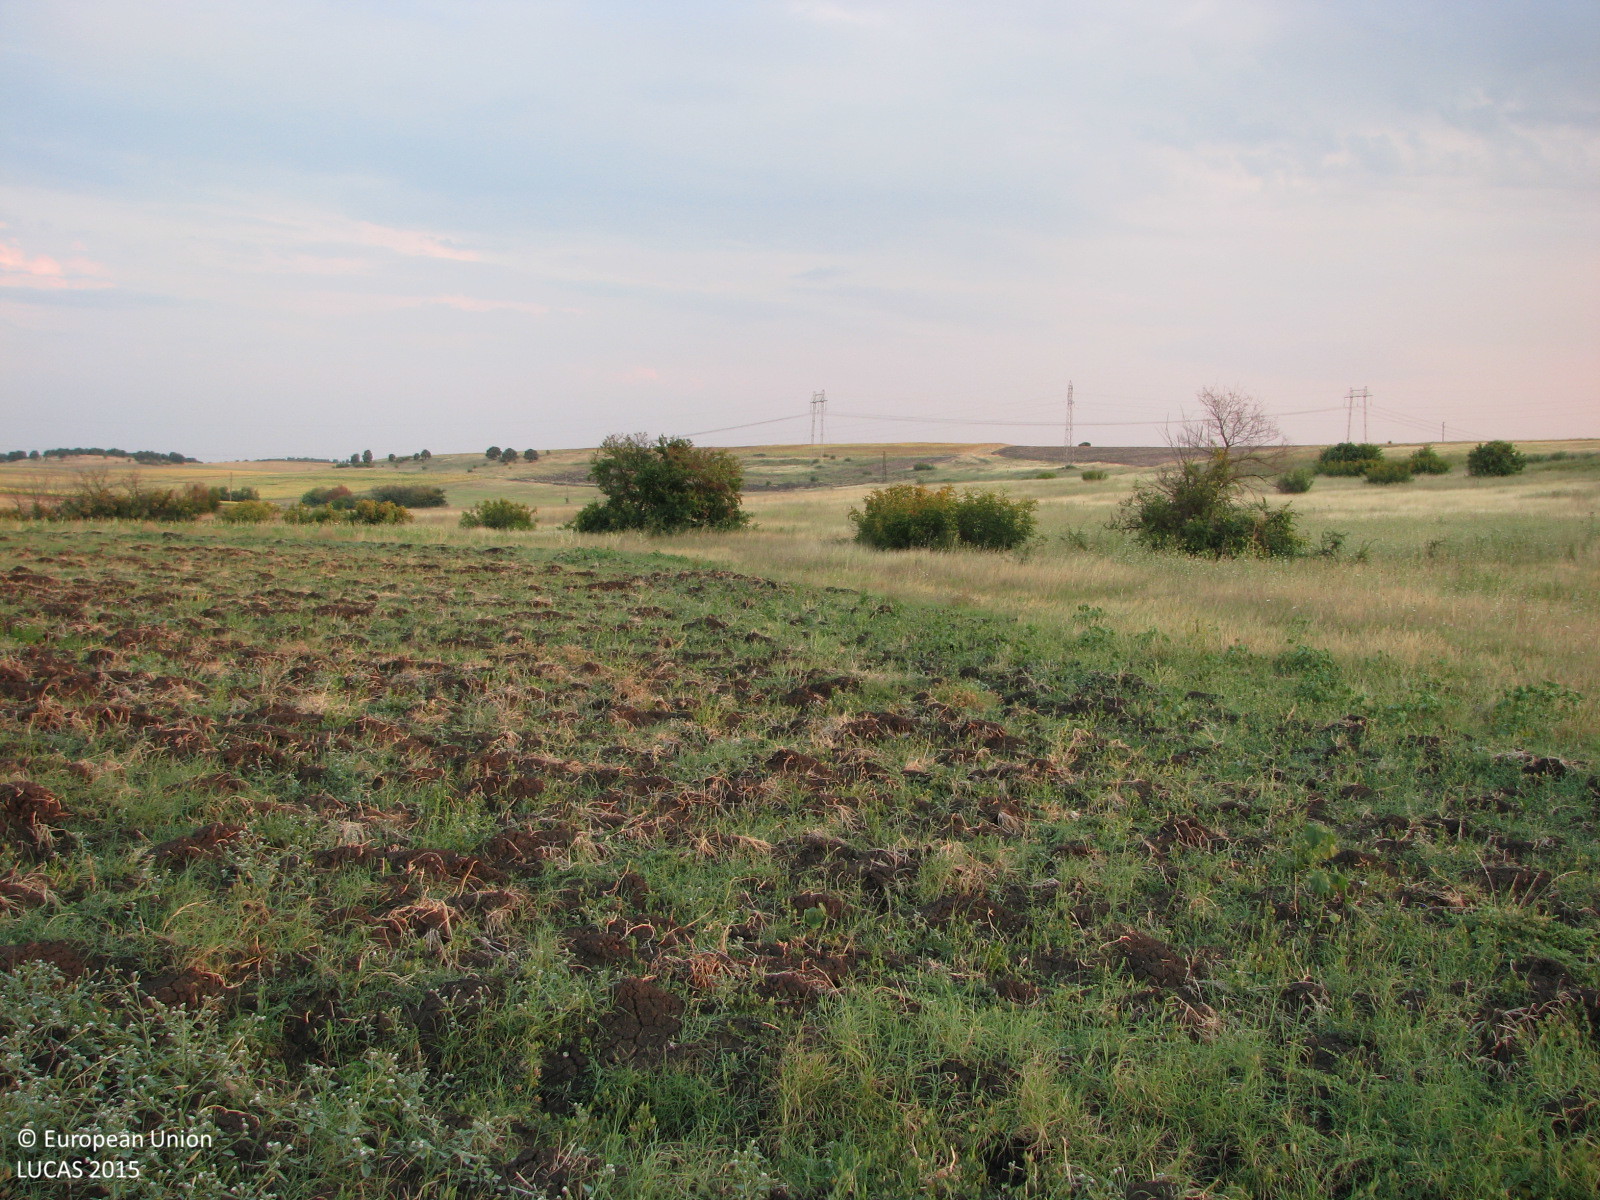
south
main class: Grassland
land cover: Spontaneously vegetated surfaces
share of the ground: > 75 %
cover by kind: herbaceous plants 90 %, unconsolidated bare surface 10 %
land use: Agriculture (excluding fallow land and kitchen gardens)
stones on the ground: < 10 %
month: August
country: BG
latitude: 42.1899
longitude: 26.3965
